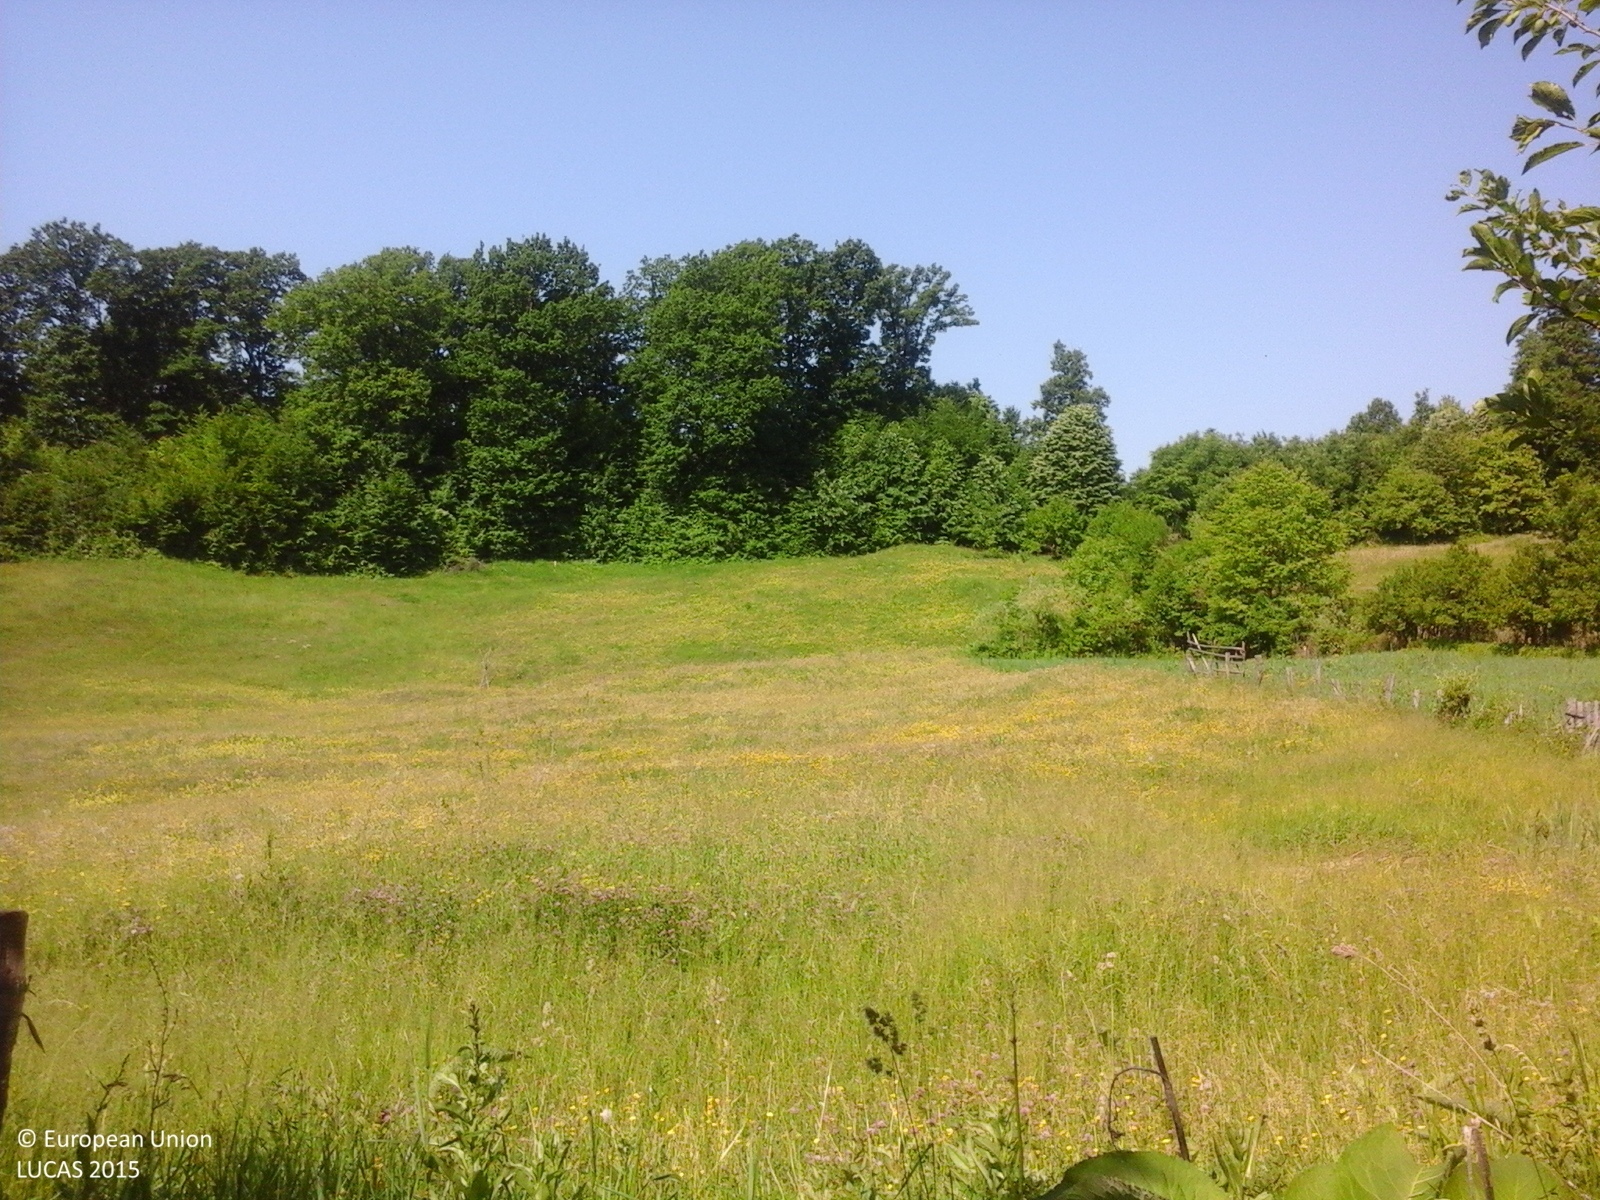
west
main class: Cropland
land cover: Vineyards
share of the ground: 50 - 75 %
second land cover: Grassland without tree/shrub cover
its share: 10 - 25 %
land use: Agriculture (excluding fallow land and kitchen gardens)
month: June
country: RO
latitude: 46.3741
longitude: 26.6608
